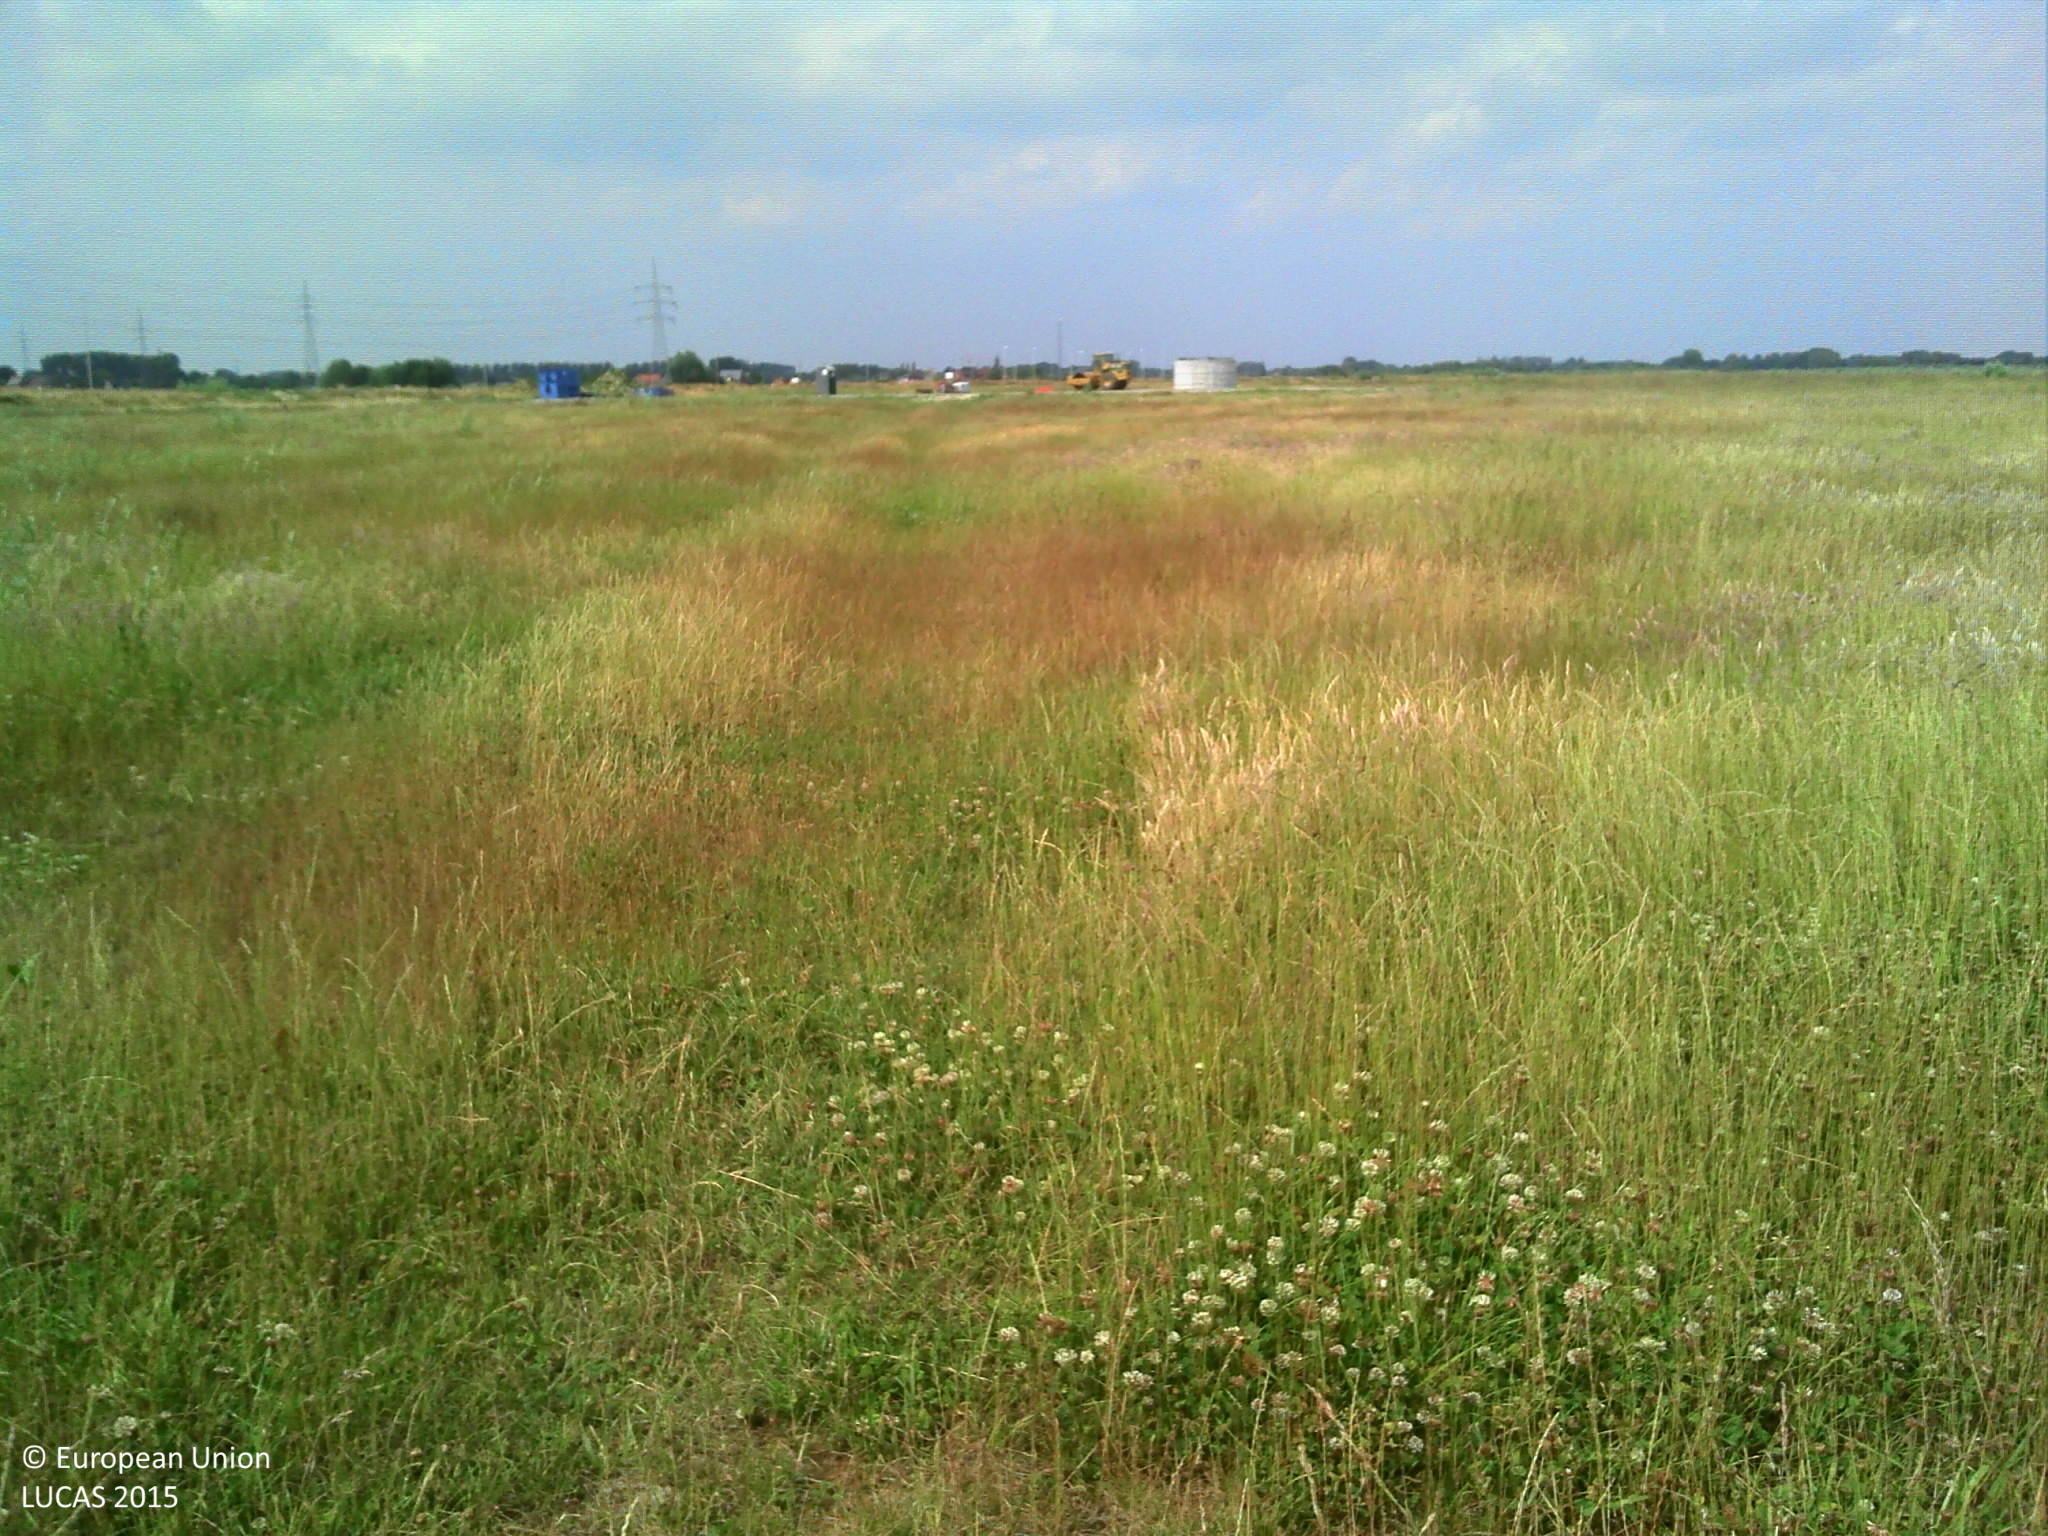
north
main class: Grassland
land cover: Grassland without tree/shrub cover
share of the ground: > 75 %
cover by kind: herbaceous plants 100 %
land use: Semi-natural and natural areas not in use
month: June
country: BE
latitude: 51.1487
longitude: 3.7460
